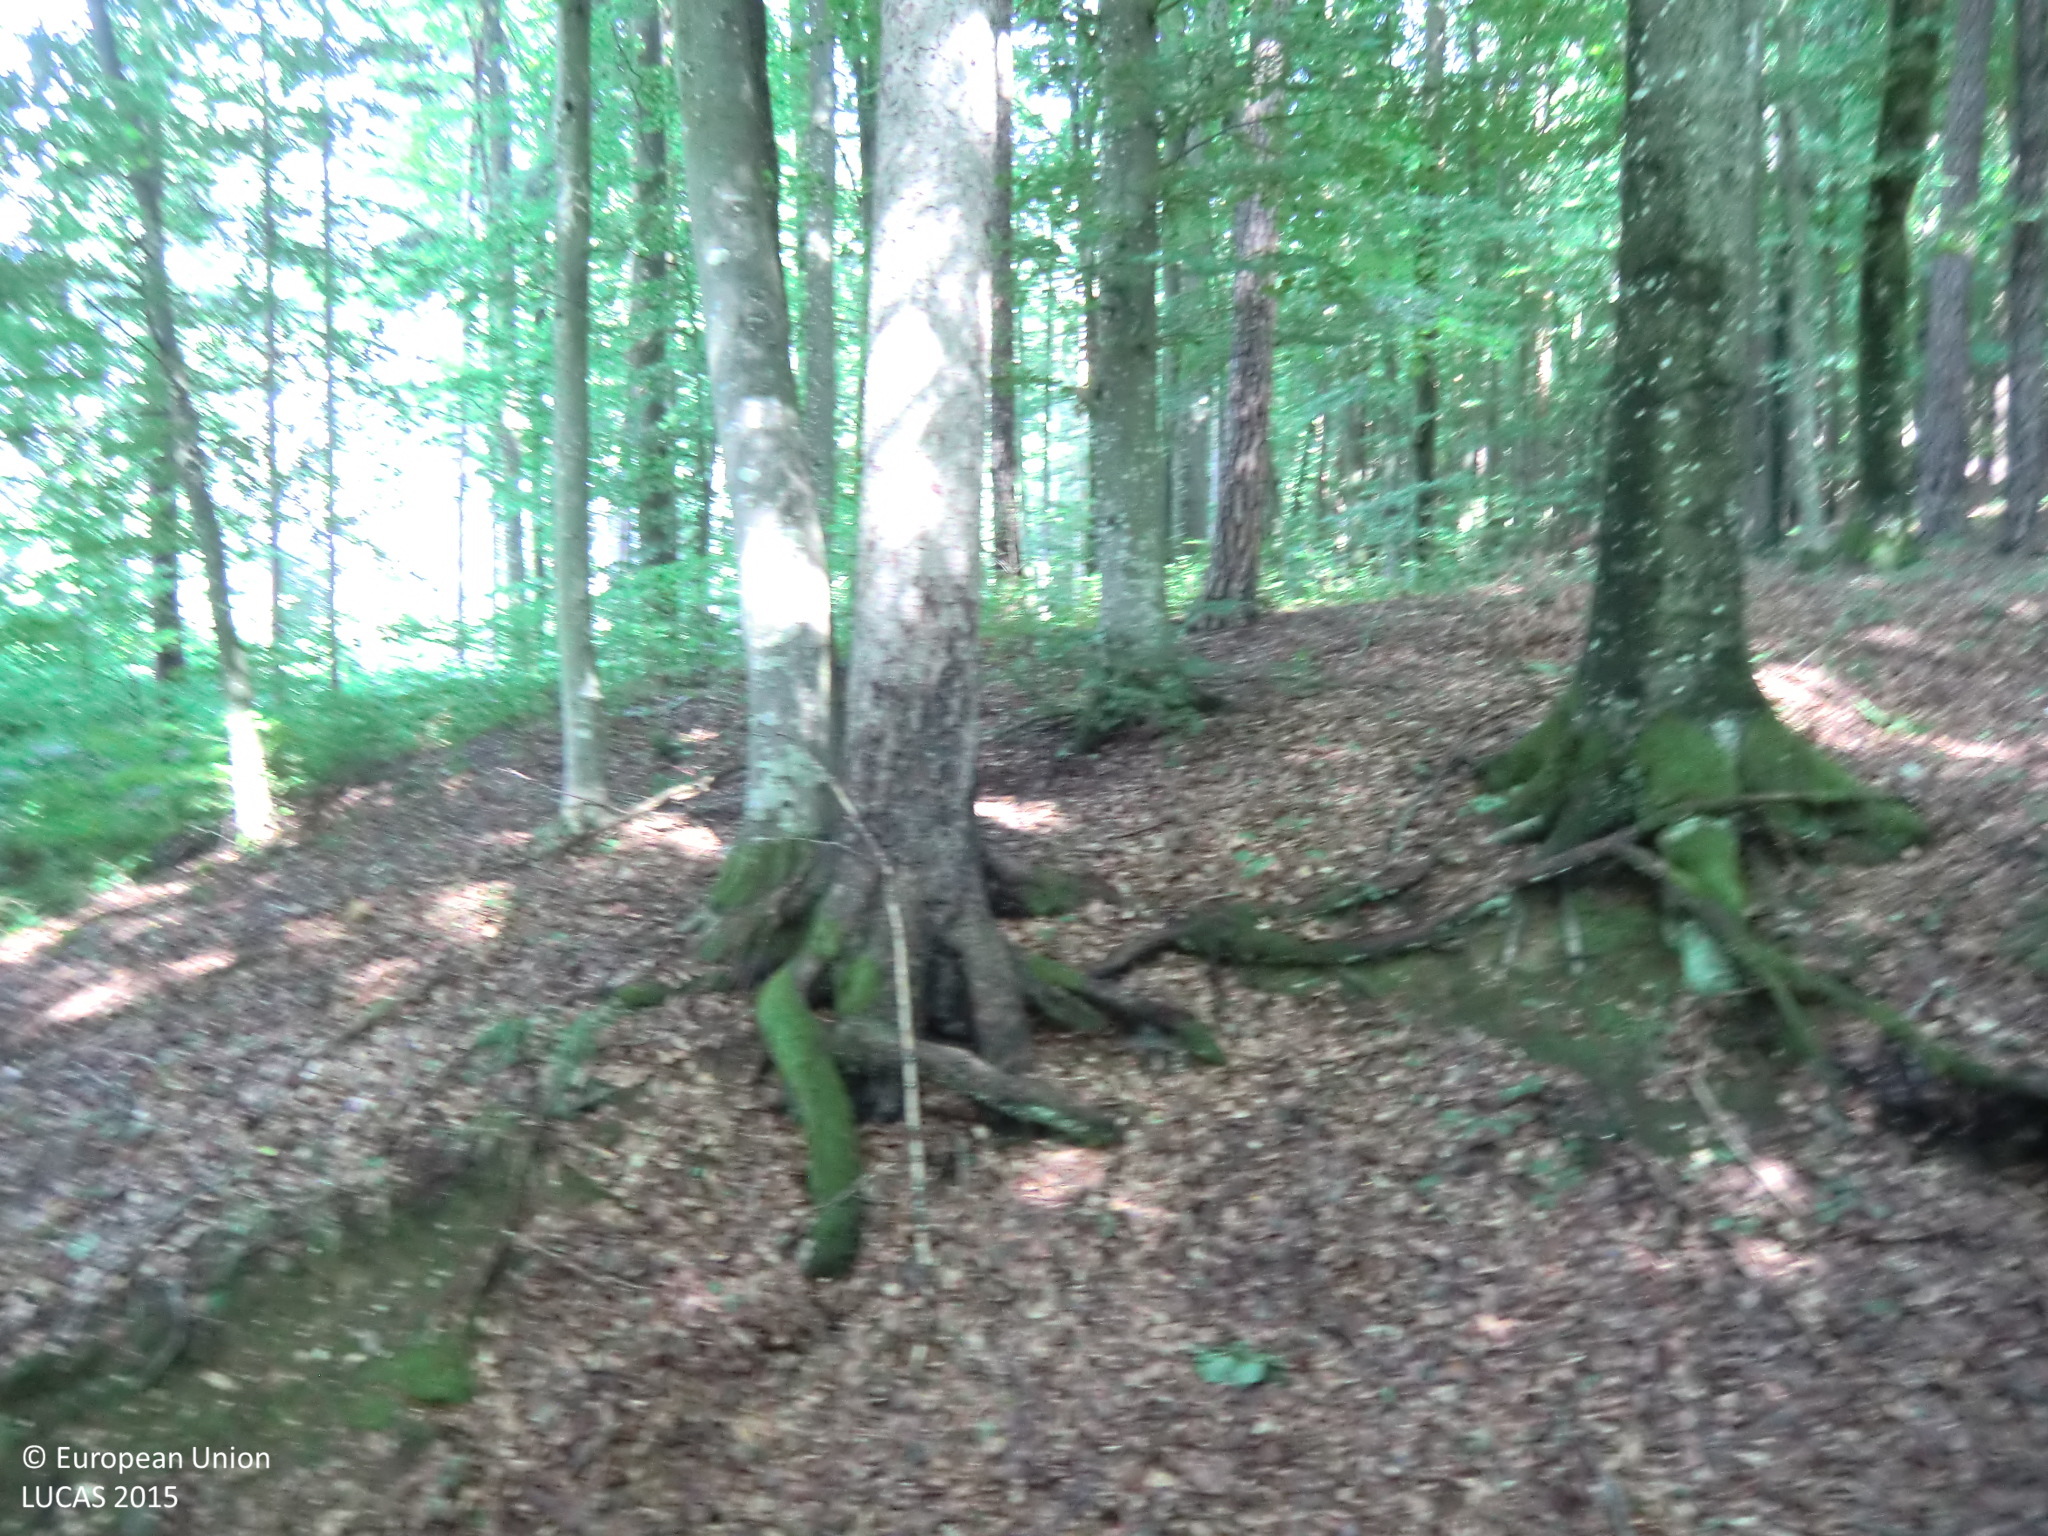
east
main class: Woodland
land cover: Pine dominated mixed woodland
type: hemiboreal forest and nemoral coniferous forest and mixed broadleaved-coniferous forest
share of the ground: > 75 %
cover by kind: broadleaved forest trees 60 %, coniferous forest trees 25 %, unconsolidated bare surface 10 %, herbaceous plants 5 %
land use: Forestry
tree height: > 5 m
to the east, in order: Pine dominated mixed woodland; Tracks; Spruce dominated mixed woodland
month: July
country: AT
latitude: 47.0283
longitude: 15.7241
